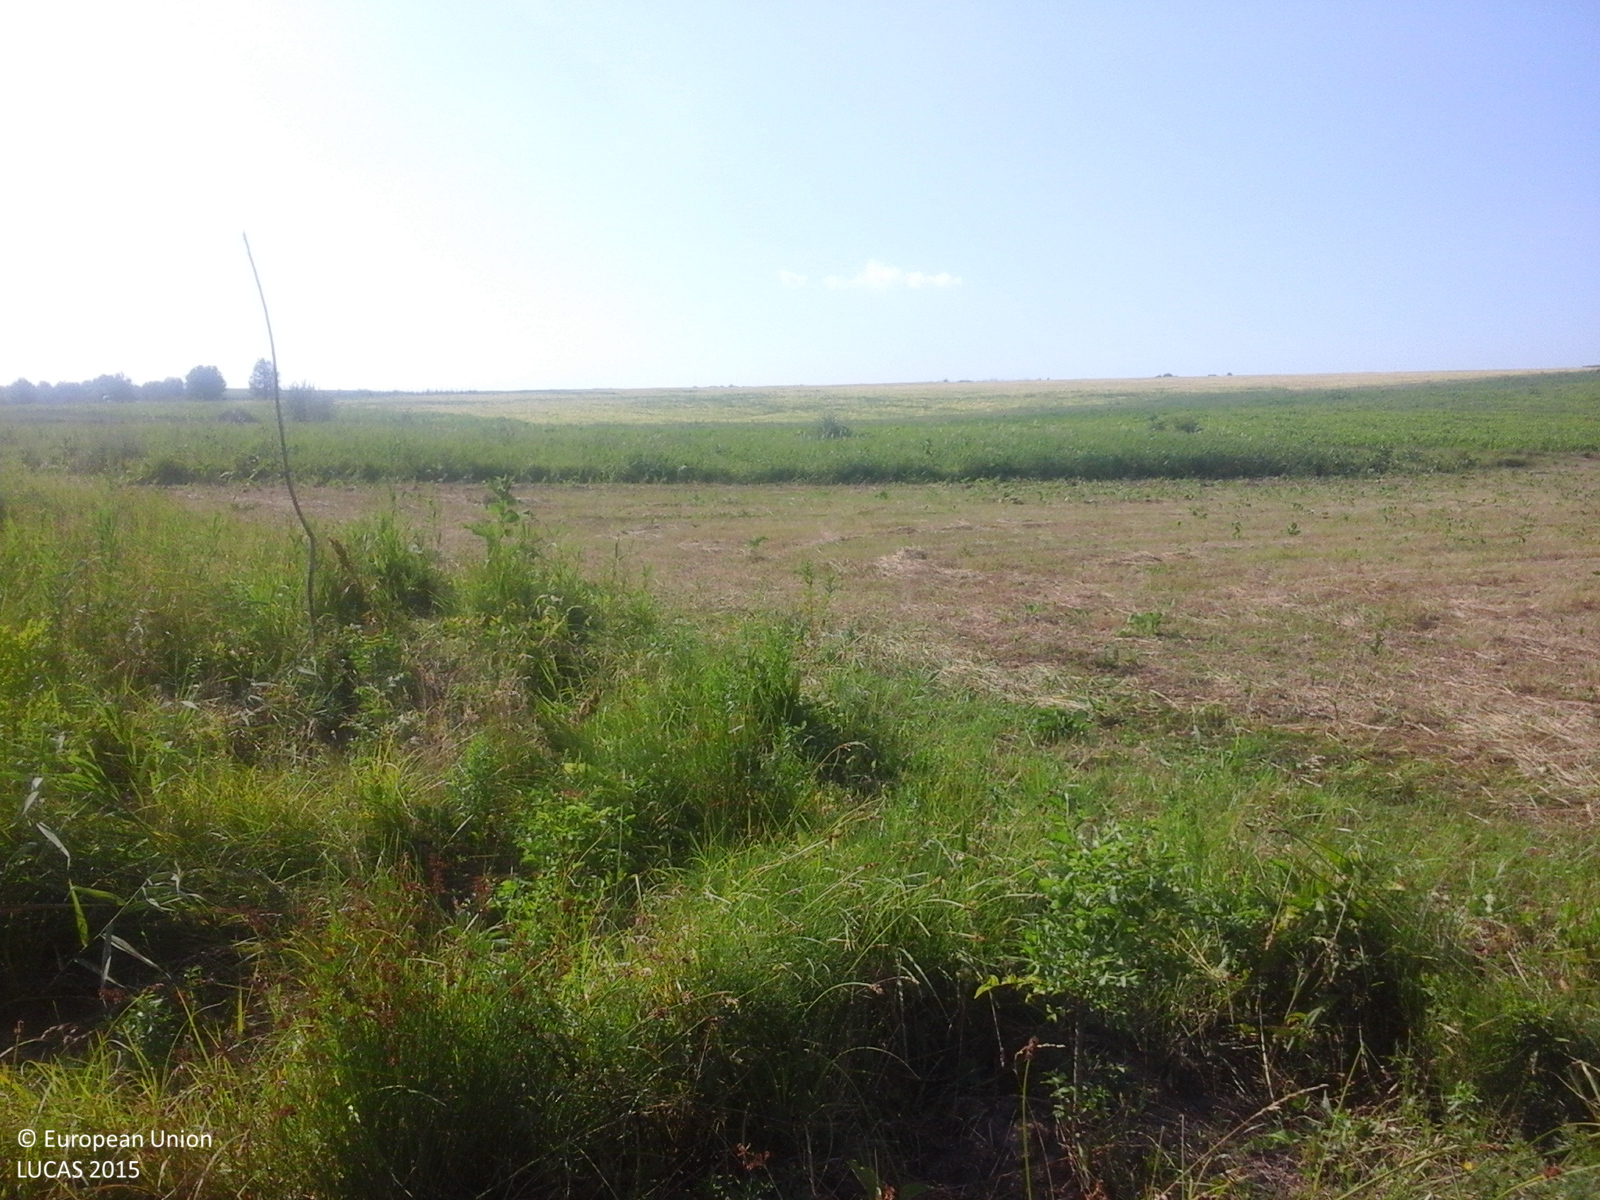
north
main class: Grassland
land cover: Grassland without tree/shrub cover
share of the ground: > 75 %
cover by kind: herbaceous plants 95 %, shrubs 5 %
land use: Agriculture (excluding fallow land and kitchen gardens)
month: June
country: RO
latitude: 46.5874
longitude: 27.7244
